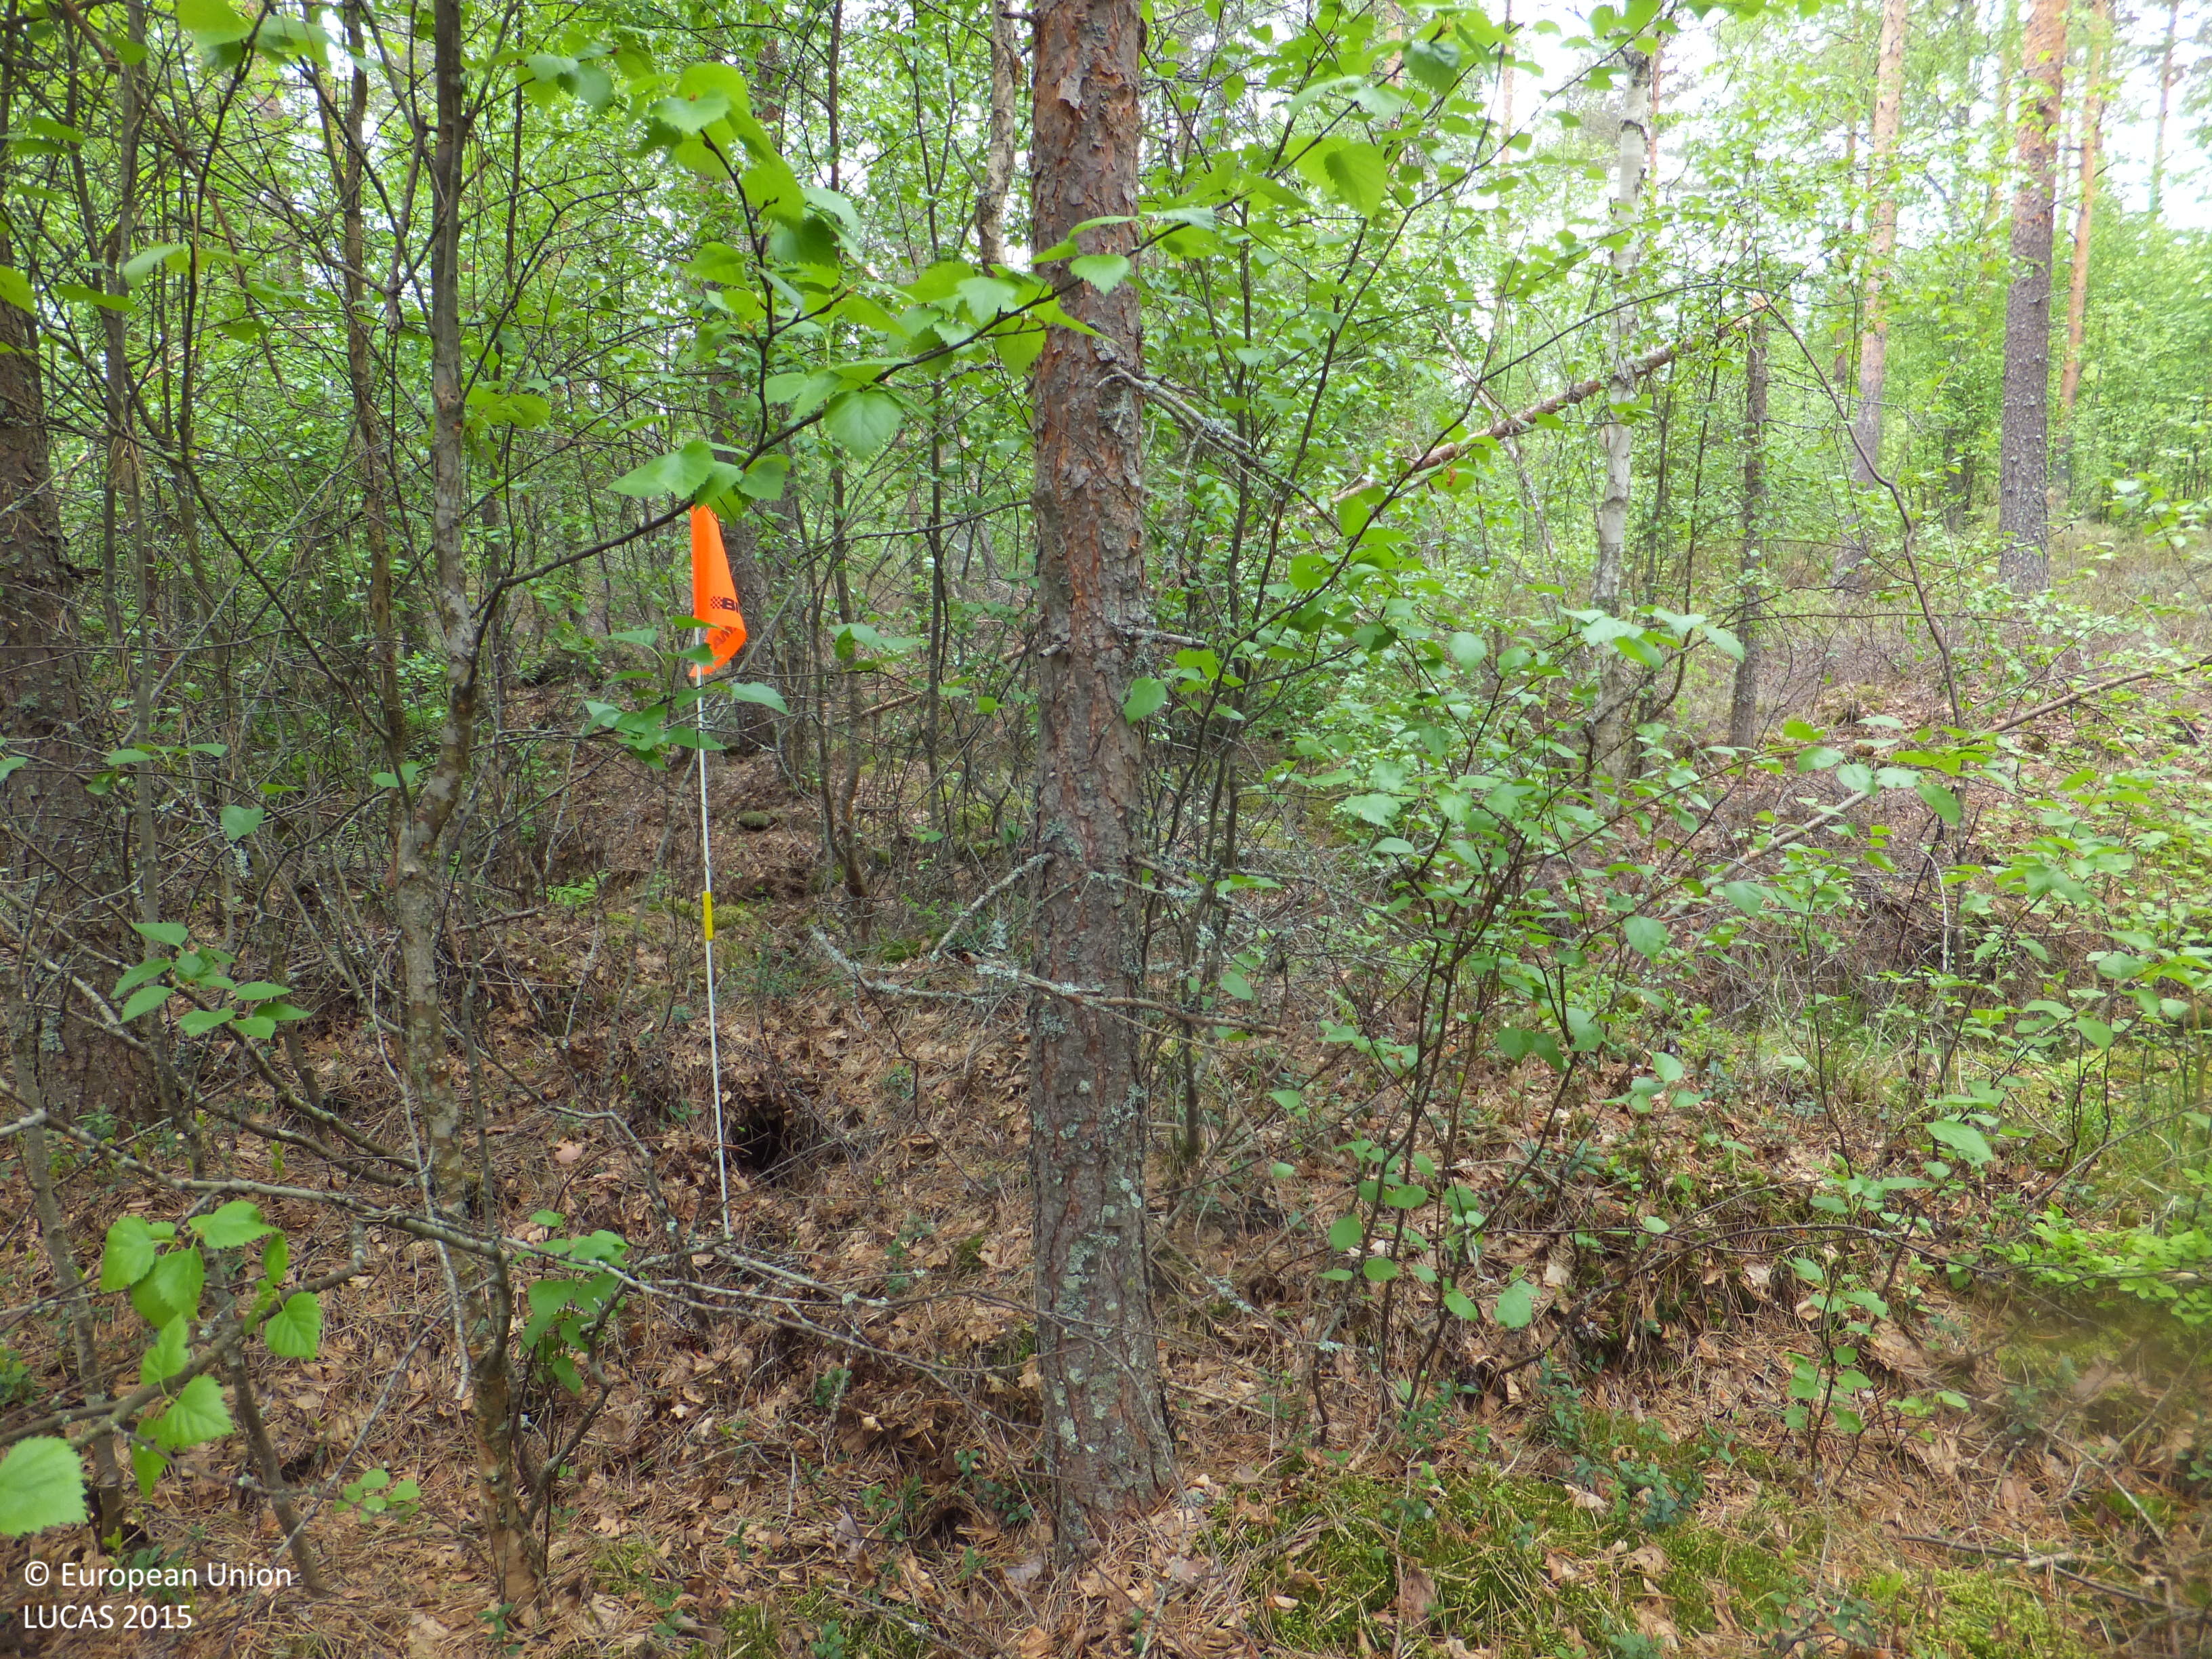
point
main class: Woodland
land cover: Pine dominated mixed woodland
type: boreal forest
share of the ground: > 75 %
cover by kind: coniferous forest trees 70 %, broadleaved forest trees 25 %, shrubs 5 %
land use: Forestry
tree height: > 5 m
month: June
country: FI
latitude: 63.3184
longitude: 22.6869
